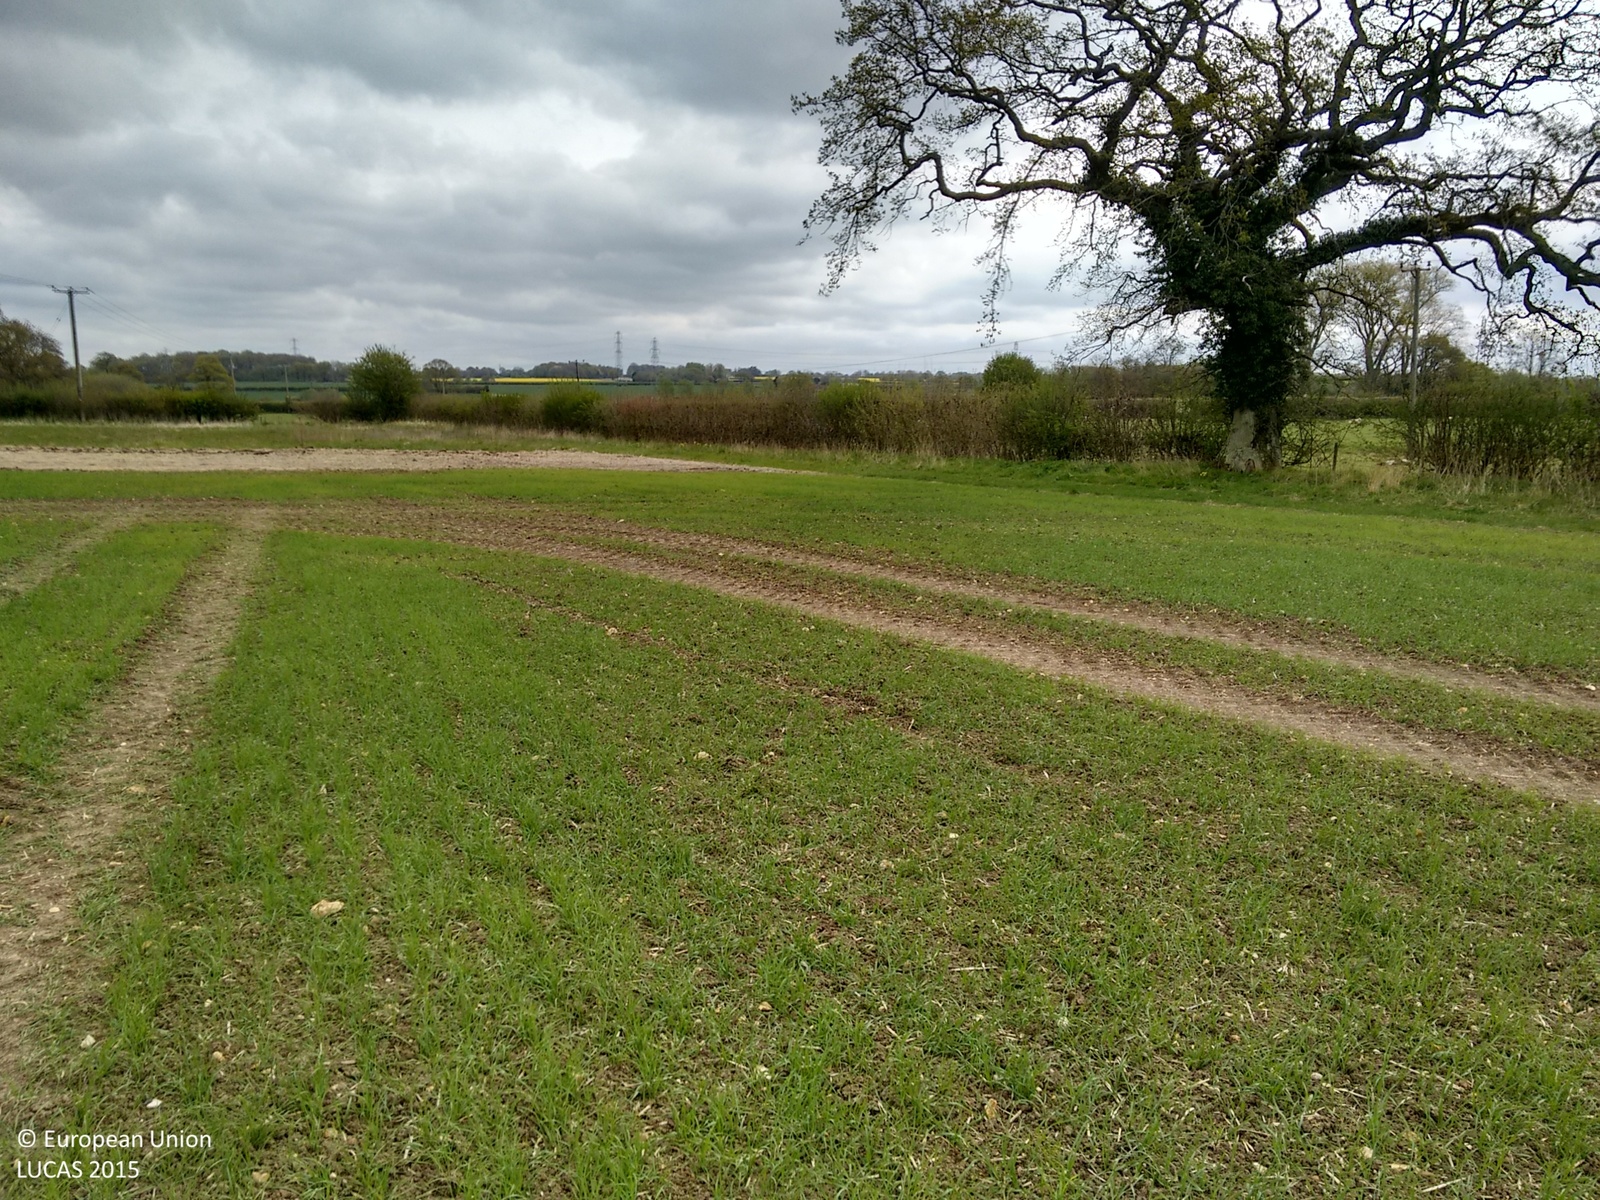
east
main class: Cropland
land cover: Common wheat
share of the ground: 50 - 75 %
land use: Agriculture (excluding fallow land and kitchen gardens)
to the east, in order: Common wheat; Spontaneously vegetated surfaces; Managed hedges; Ditches and canals; Fences; Grassland without tree/shrub cover; Ditches and canals; Fences; Grassland without tree/shrub cover; Electric lines; Fences; Managed hedges; Grass margins; Other bare soil
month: May
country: GB
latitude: 51.1229
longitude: -0.9741
